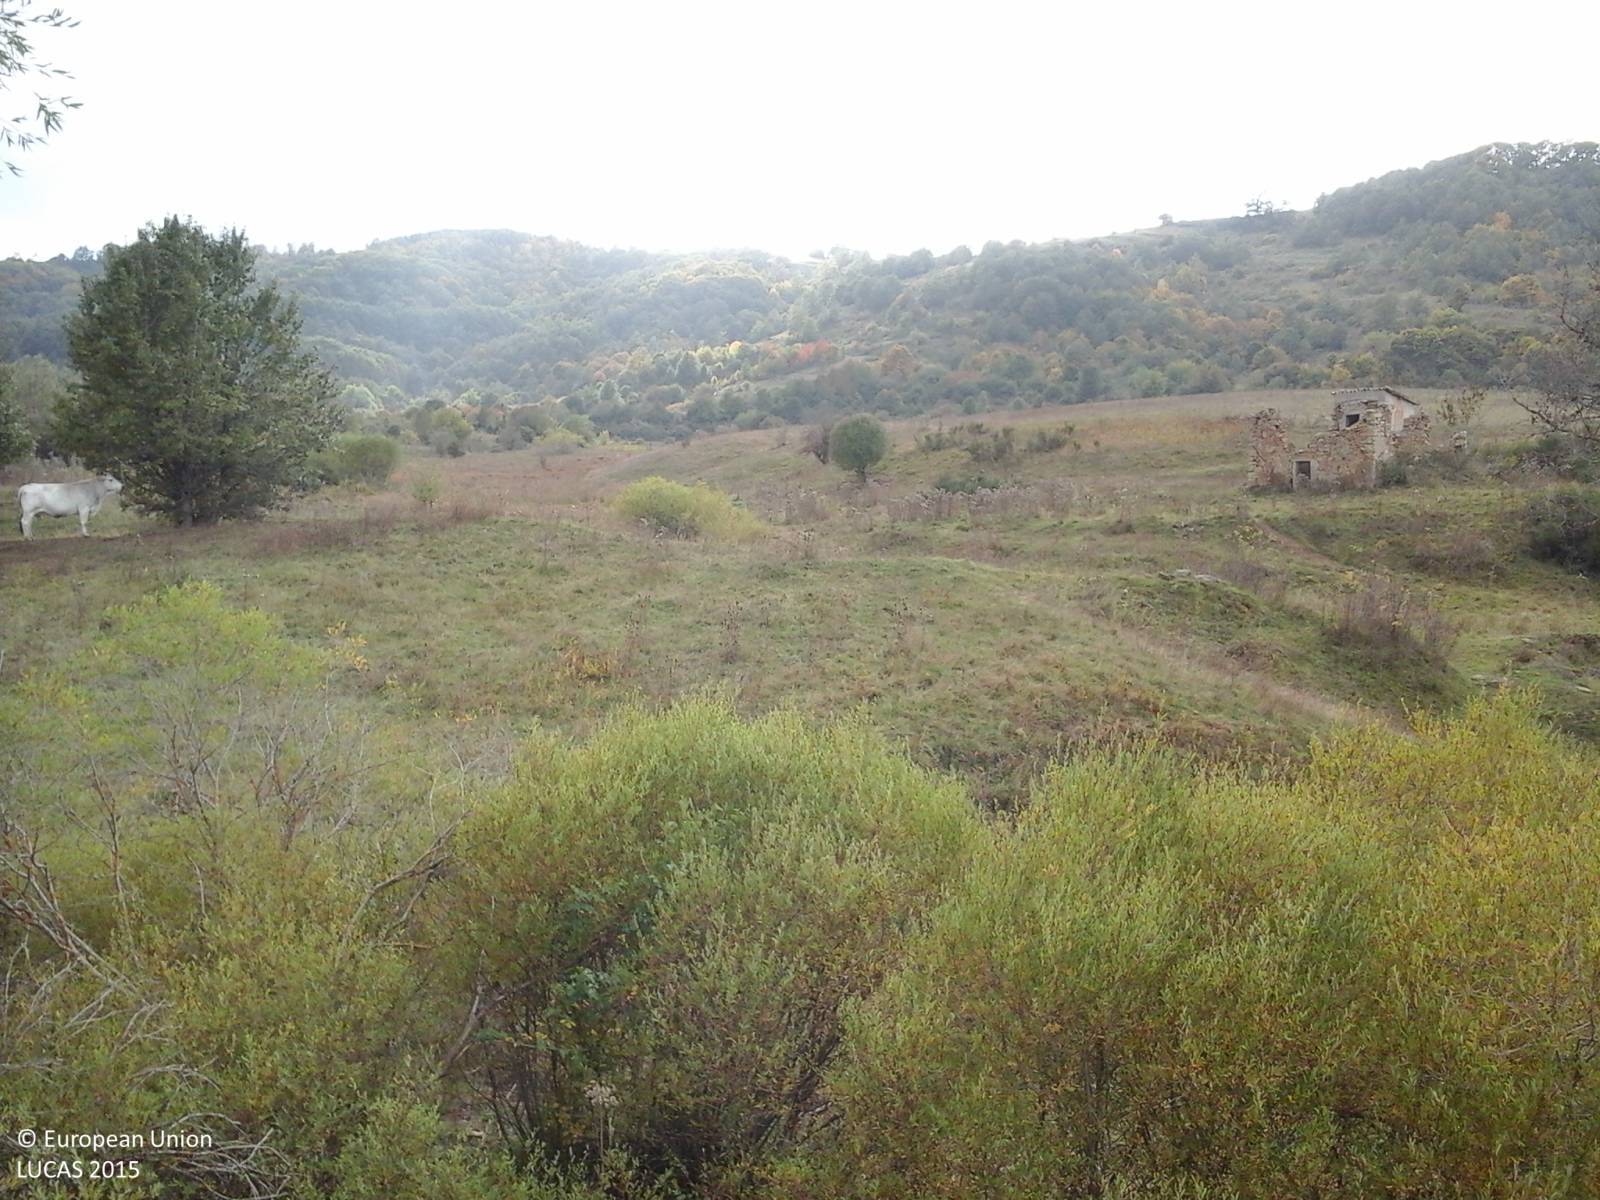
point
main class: Grassland
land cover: Grassland without tree/shrub cover
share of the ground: > 75 %
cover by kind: herbaceous plants 100 %
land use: Agriculture (excluding fallow land and kitchen gardens)
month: October
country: IT
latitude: 42.5817
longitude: 13.3161
